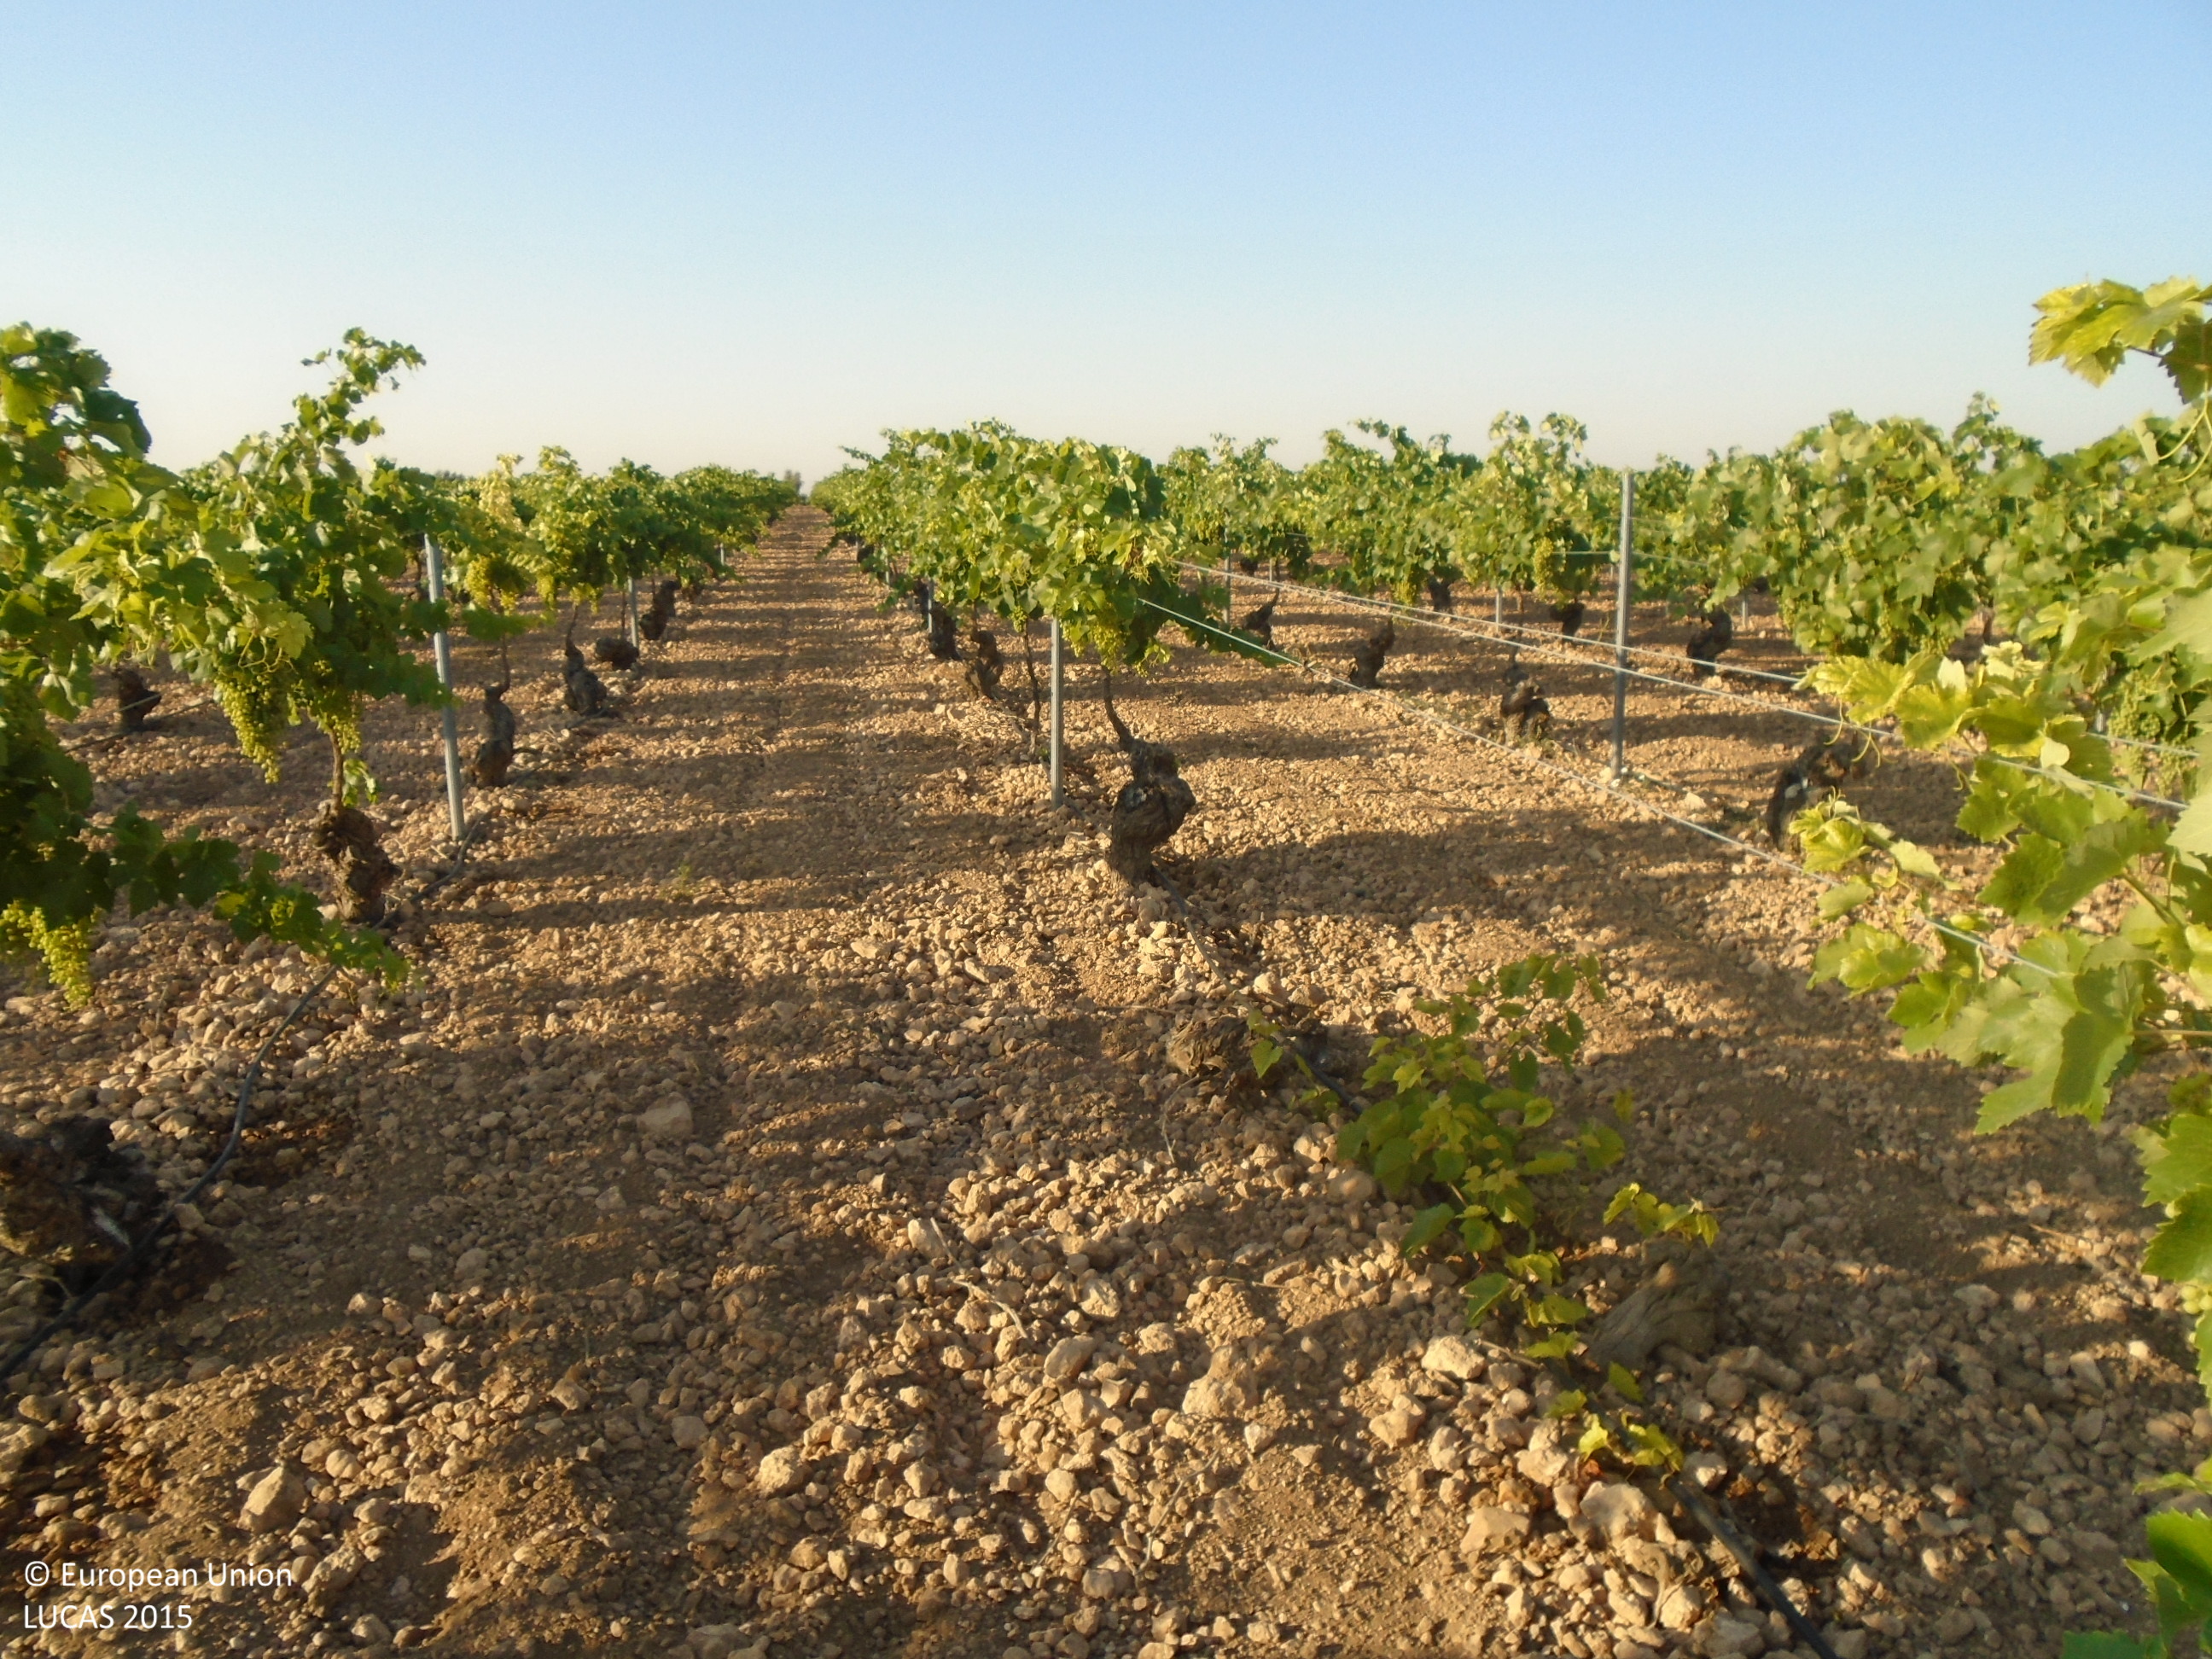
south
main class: Cropland
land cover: Vineyards
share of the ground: 10 - 25 %
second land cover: Other bare soil
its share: > 75 %
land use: Agriculture (excluding fallow land and kitchen gardens)
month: June
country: ES
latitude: 39.1484
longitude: -3.6149
